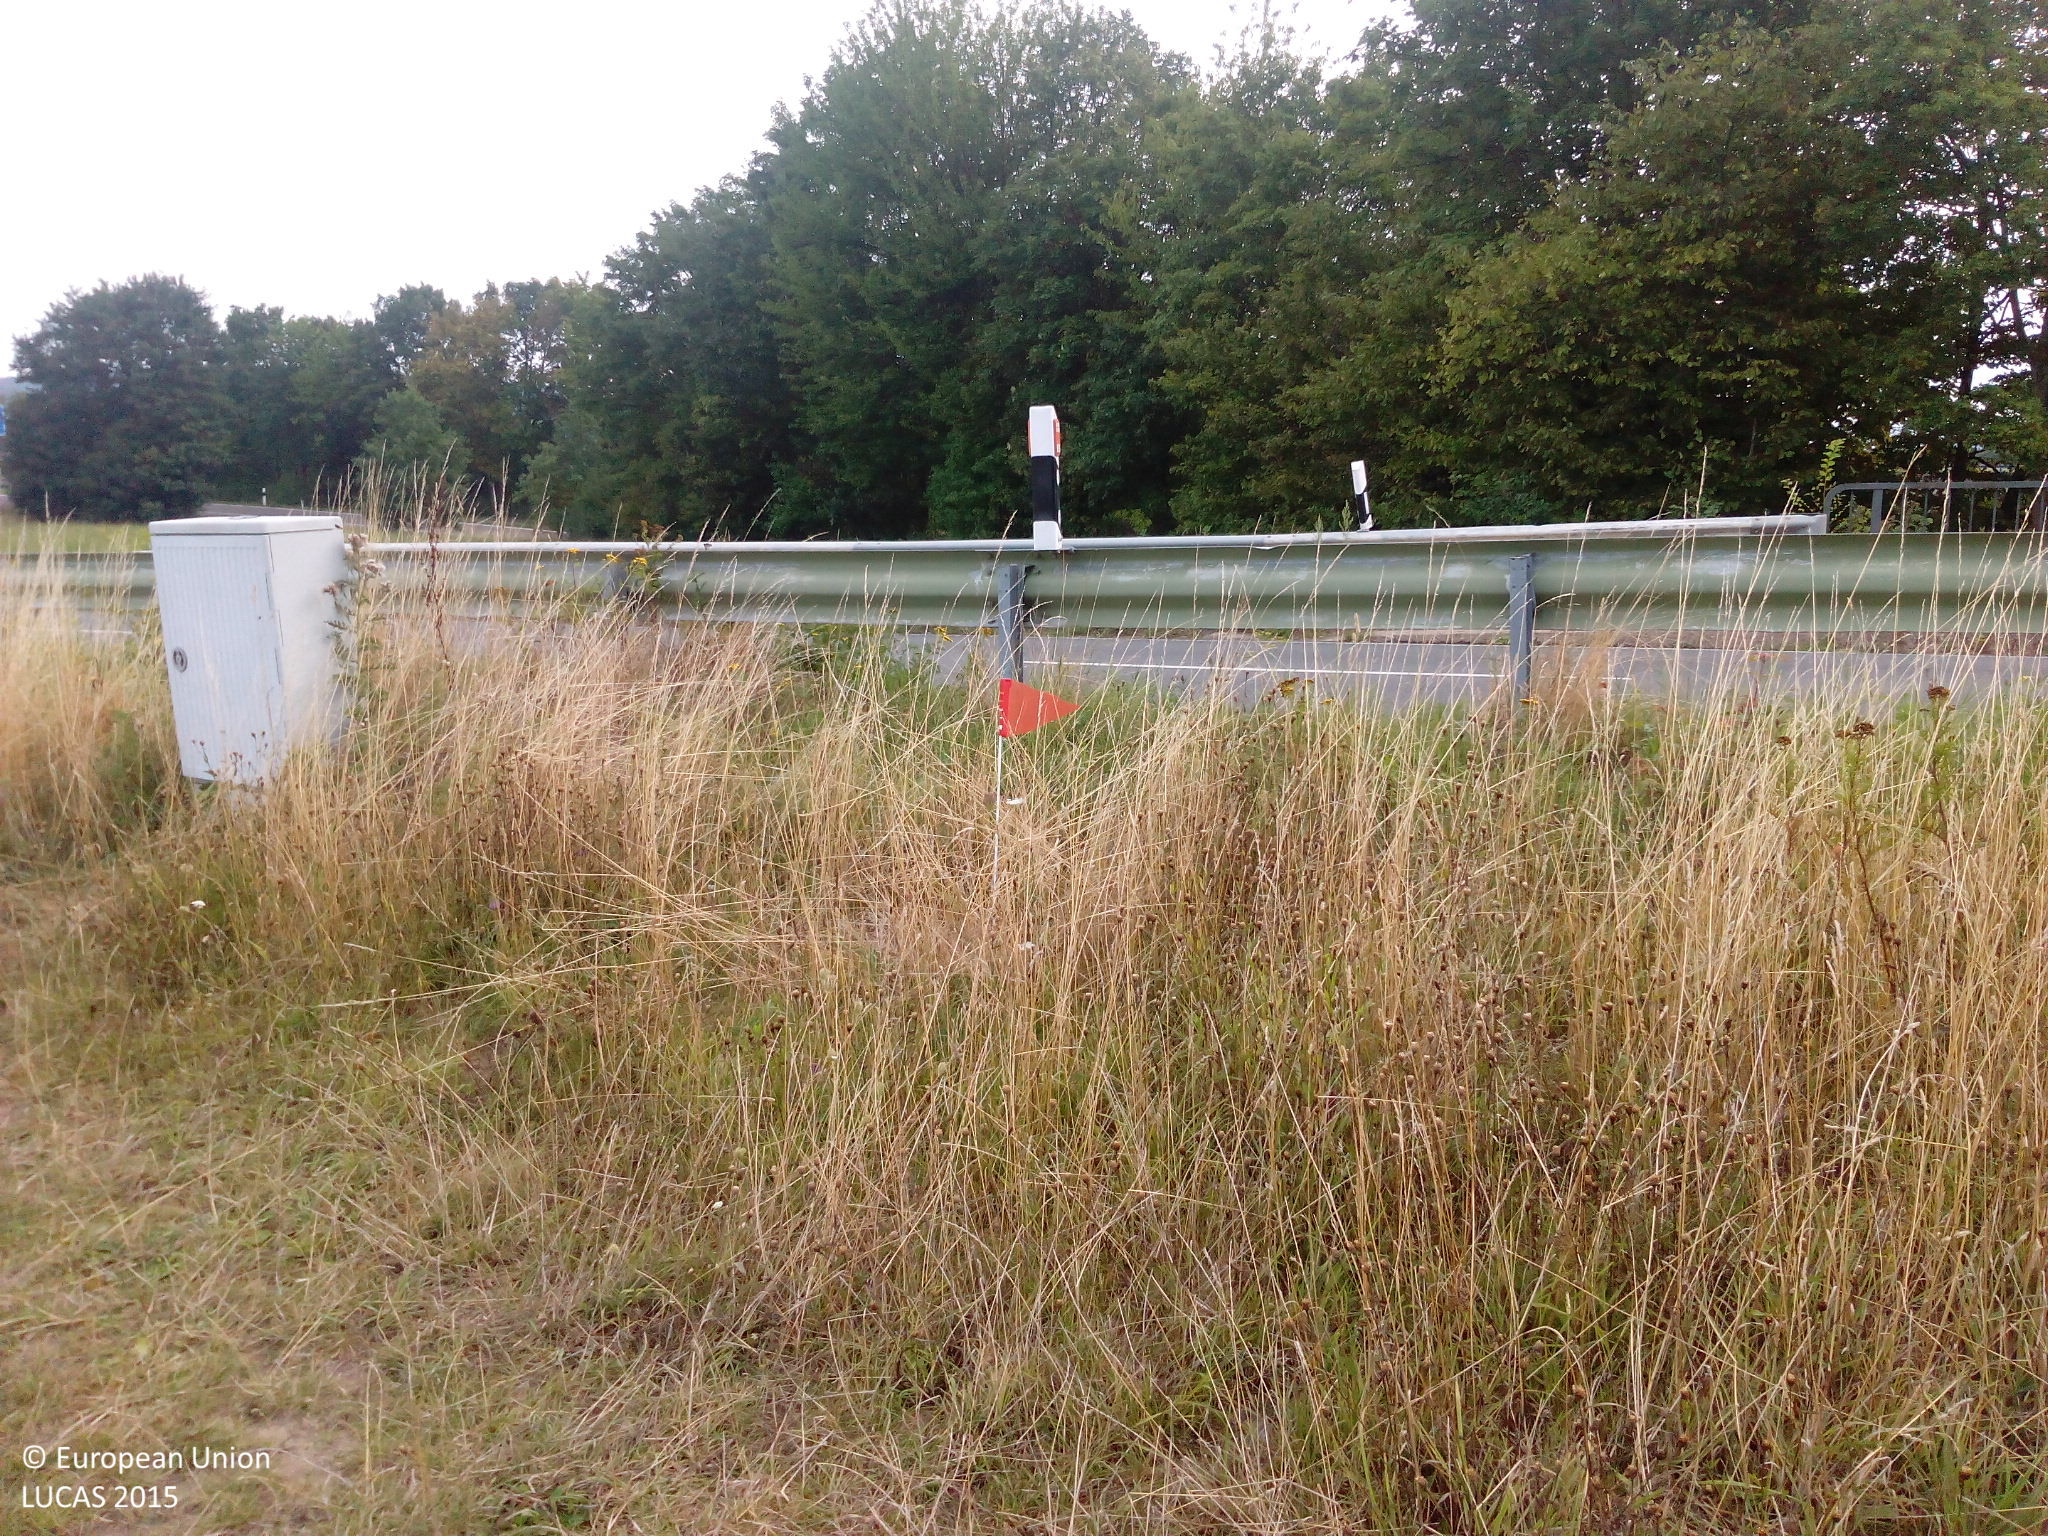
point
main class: Grassland
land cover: Grassland without tree/shrub cover
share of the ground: > 75 %
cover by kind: herbaceous plants 95 %, unconsolidated bare surface 5 %
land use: Road transport
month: August
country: DE
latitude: 50.3005
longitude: 7.4873
